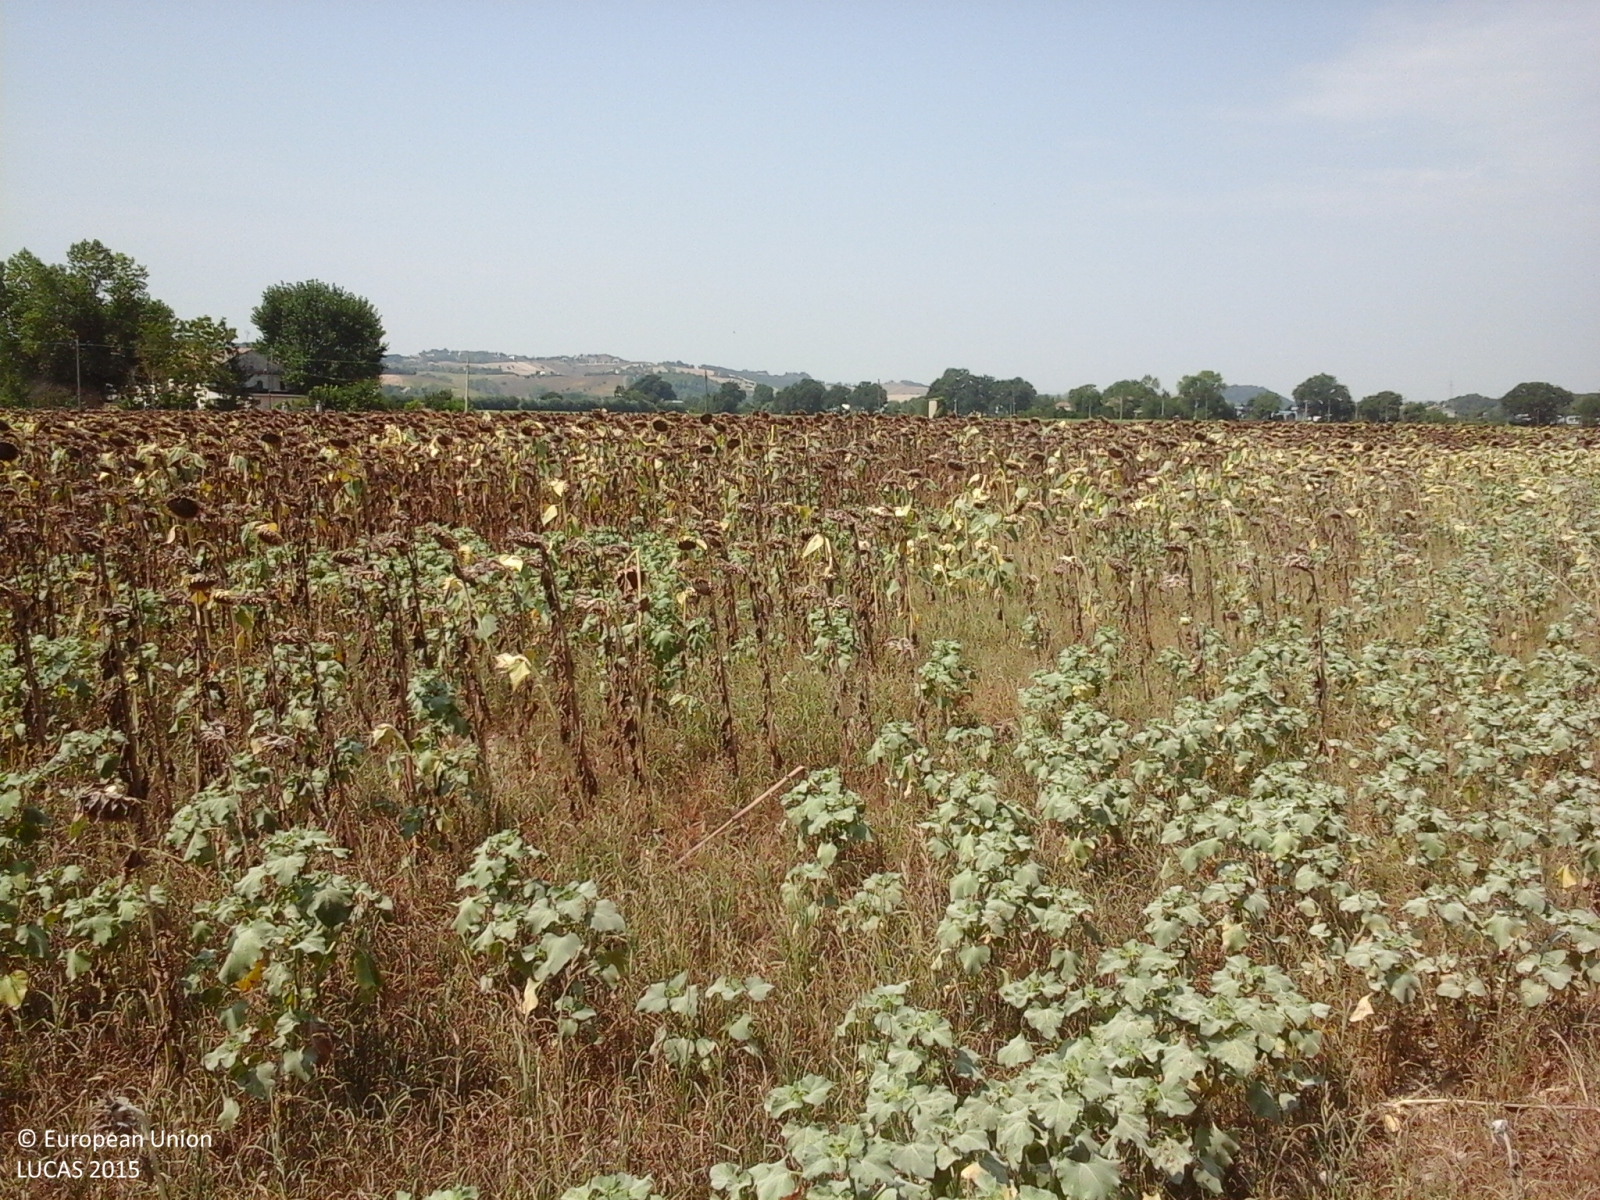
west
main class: Cropland
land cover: Sunflower
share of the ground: > 75 %
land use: Agriculture (excluding fallow land and kitchen gardens)
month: August
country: IT
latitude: 43.4621
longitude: 13.4646
